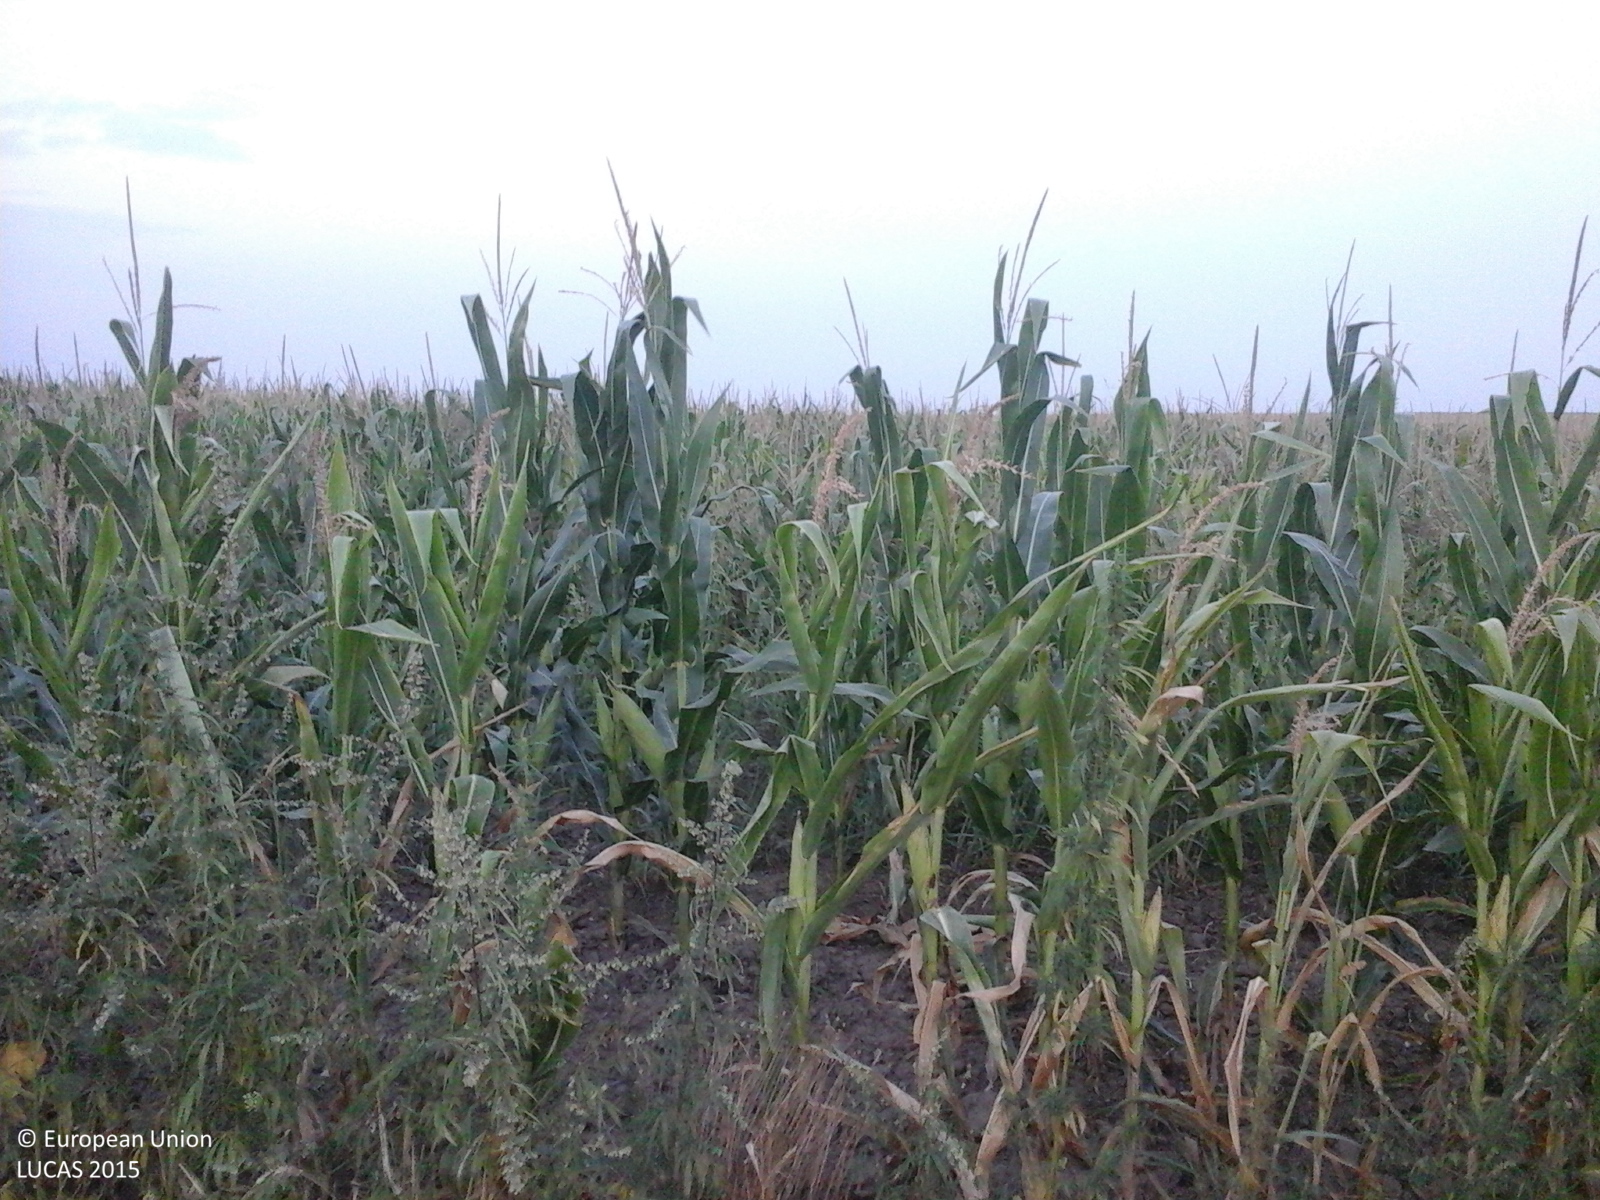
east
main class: Cropland
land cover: Maize
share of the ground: > 75 %
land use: Agriculture (excluding fallow land and kitchen gardens)
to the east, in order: Maize
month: August
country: RO
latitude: 44.2325
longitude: 28.1245
